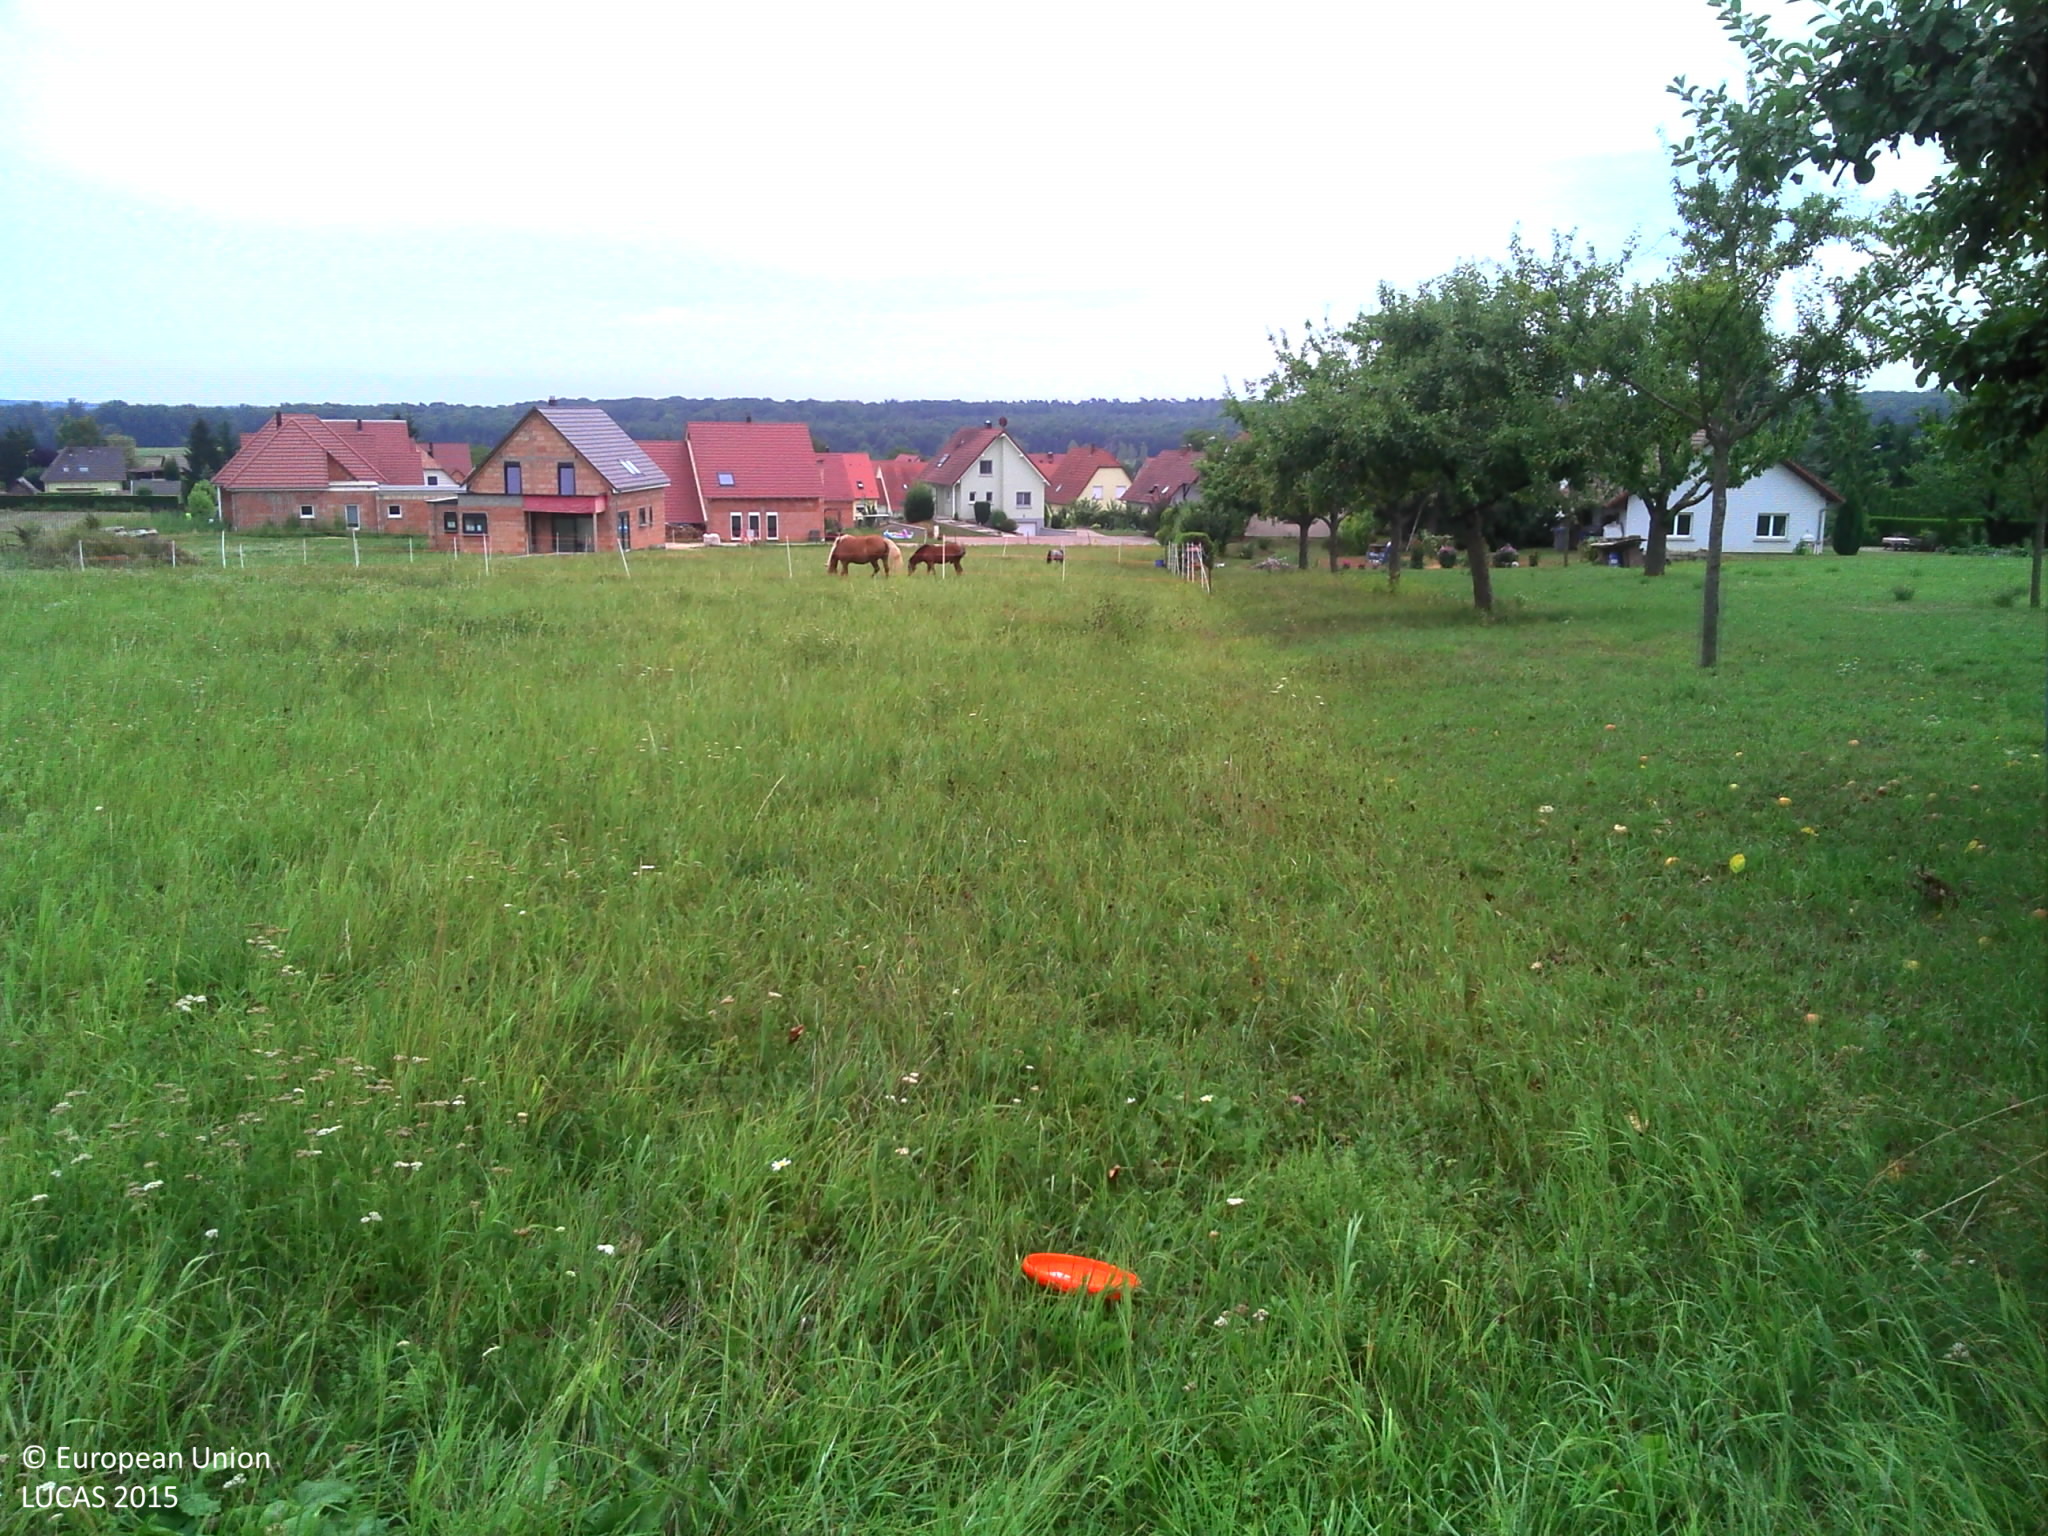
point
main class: Grassland
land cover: Grassland without tree/shrub cover
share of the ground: > 75 %
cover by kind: herbaceous plants 100 %
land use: Agriculture (excluding fallow land and kitchen gardens)
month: August
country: FR
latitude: 48.8823
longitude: 7.6415
